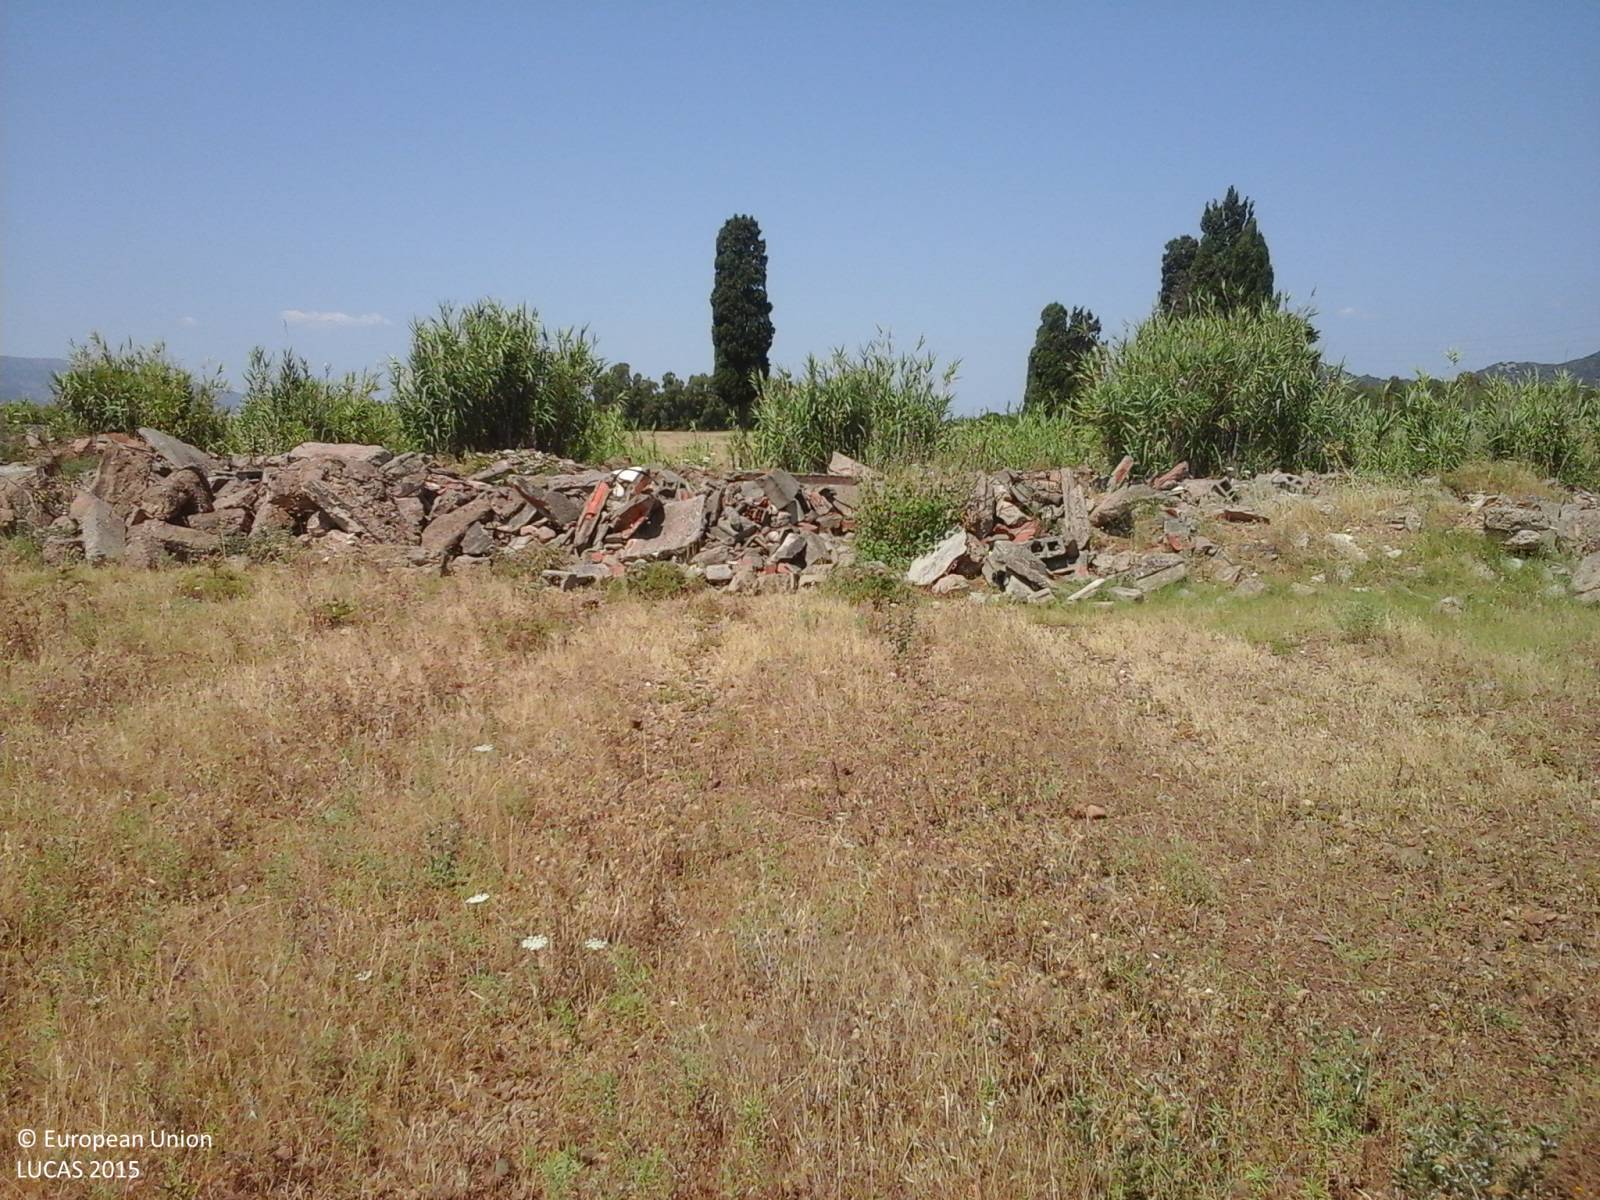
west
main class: Grassland
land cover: Grassland without tree/shrub cover
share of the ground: > 75 %
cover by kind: herbaceous plants 100 %
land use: Agriculture (excluding fallow land and kitchen gardens)
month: June
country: IT
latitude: 39.3012
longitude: 8.9051
